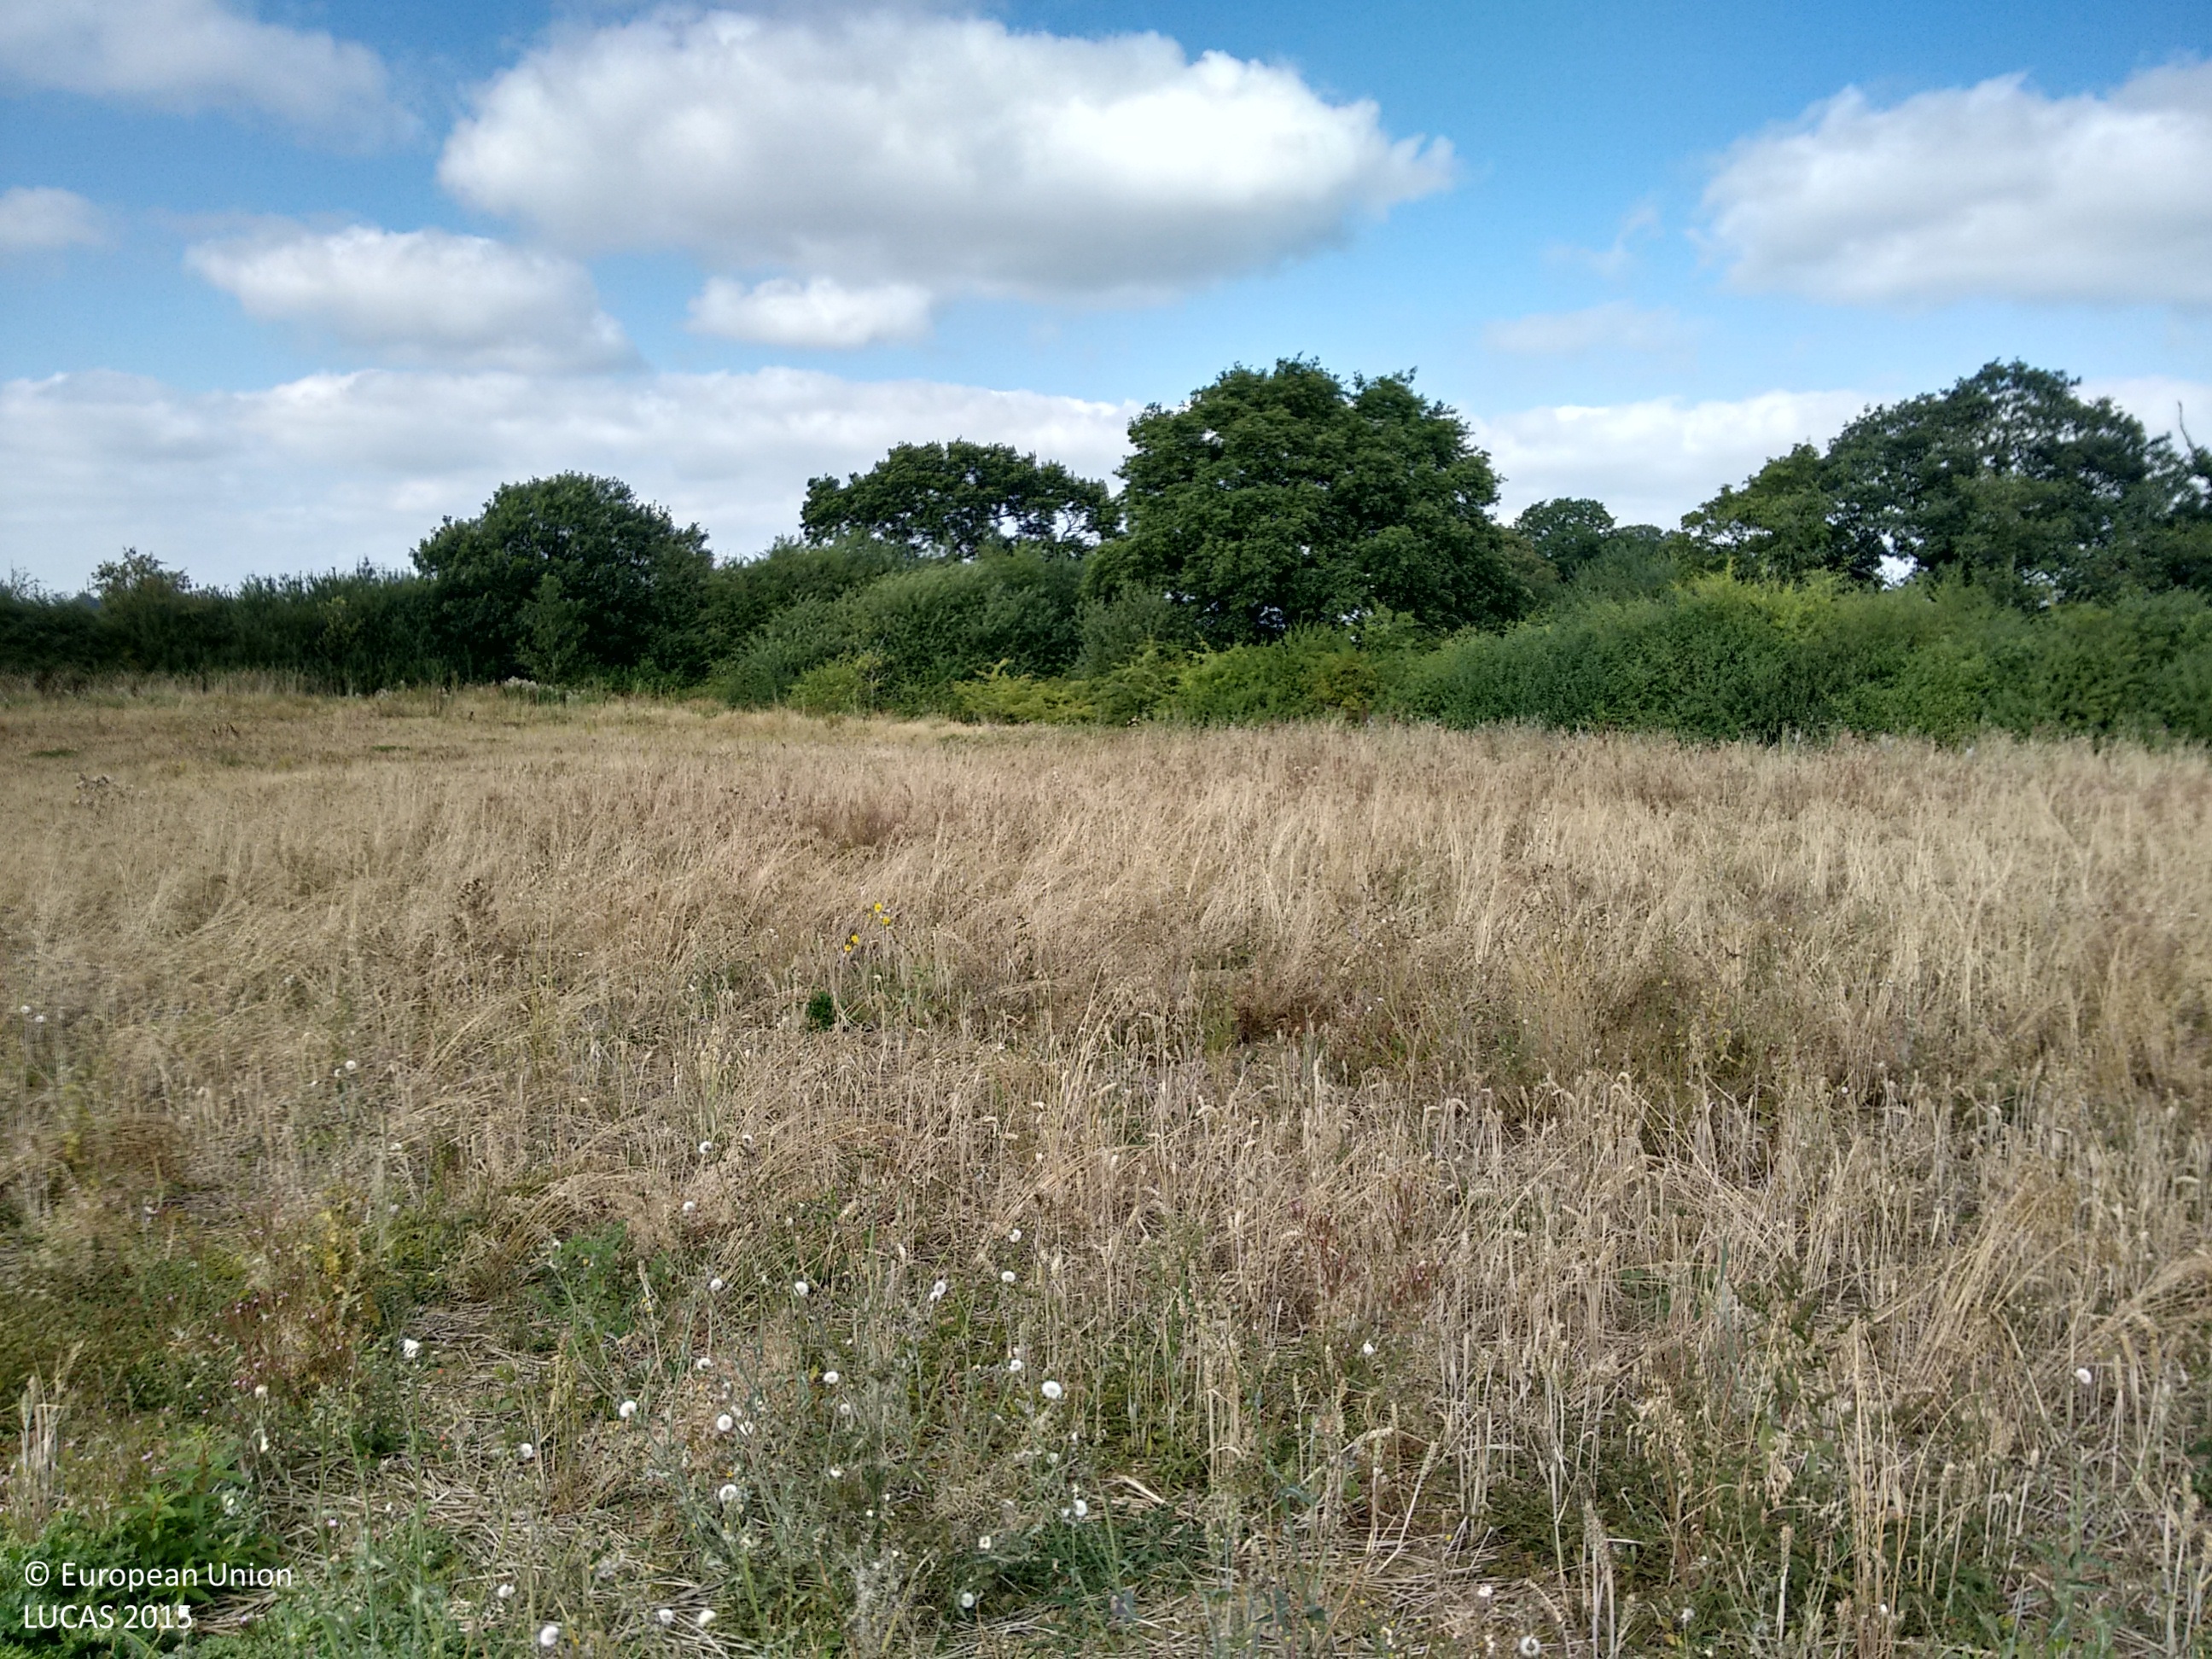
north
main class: Cropland
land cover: Barley
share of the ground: > 75 %
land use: Agriculture (excluding fallow land and kitchen gardens)
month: September
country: GB
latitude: 52.8262
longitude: -2.8200
